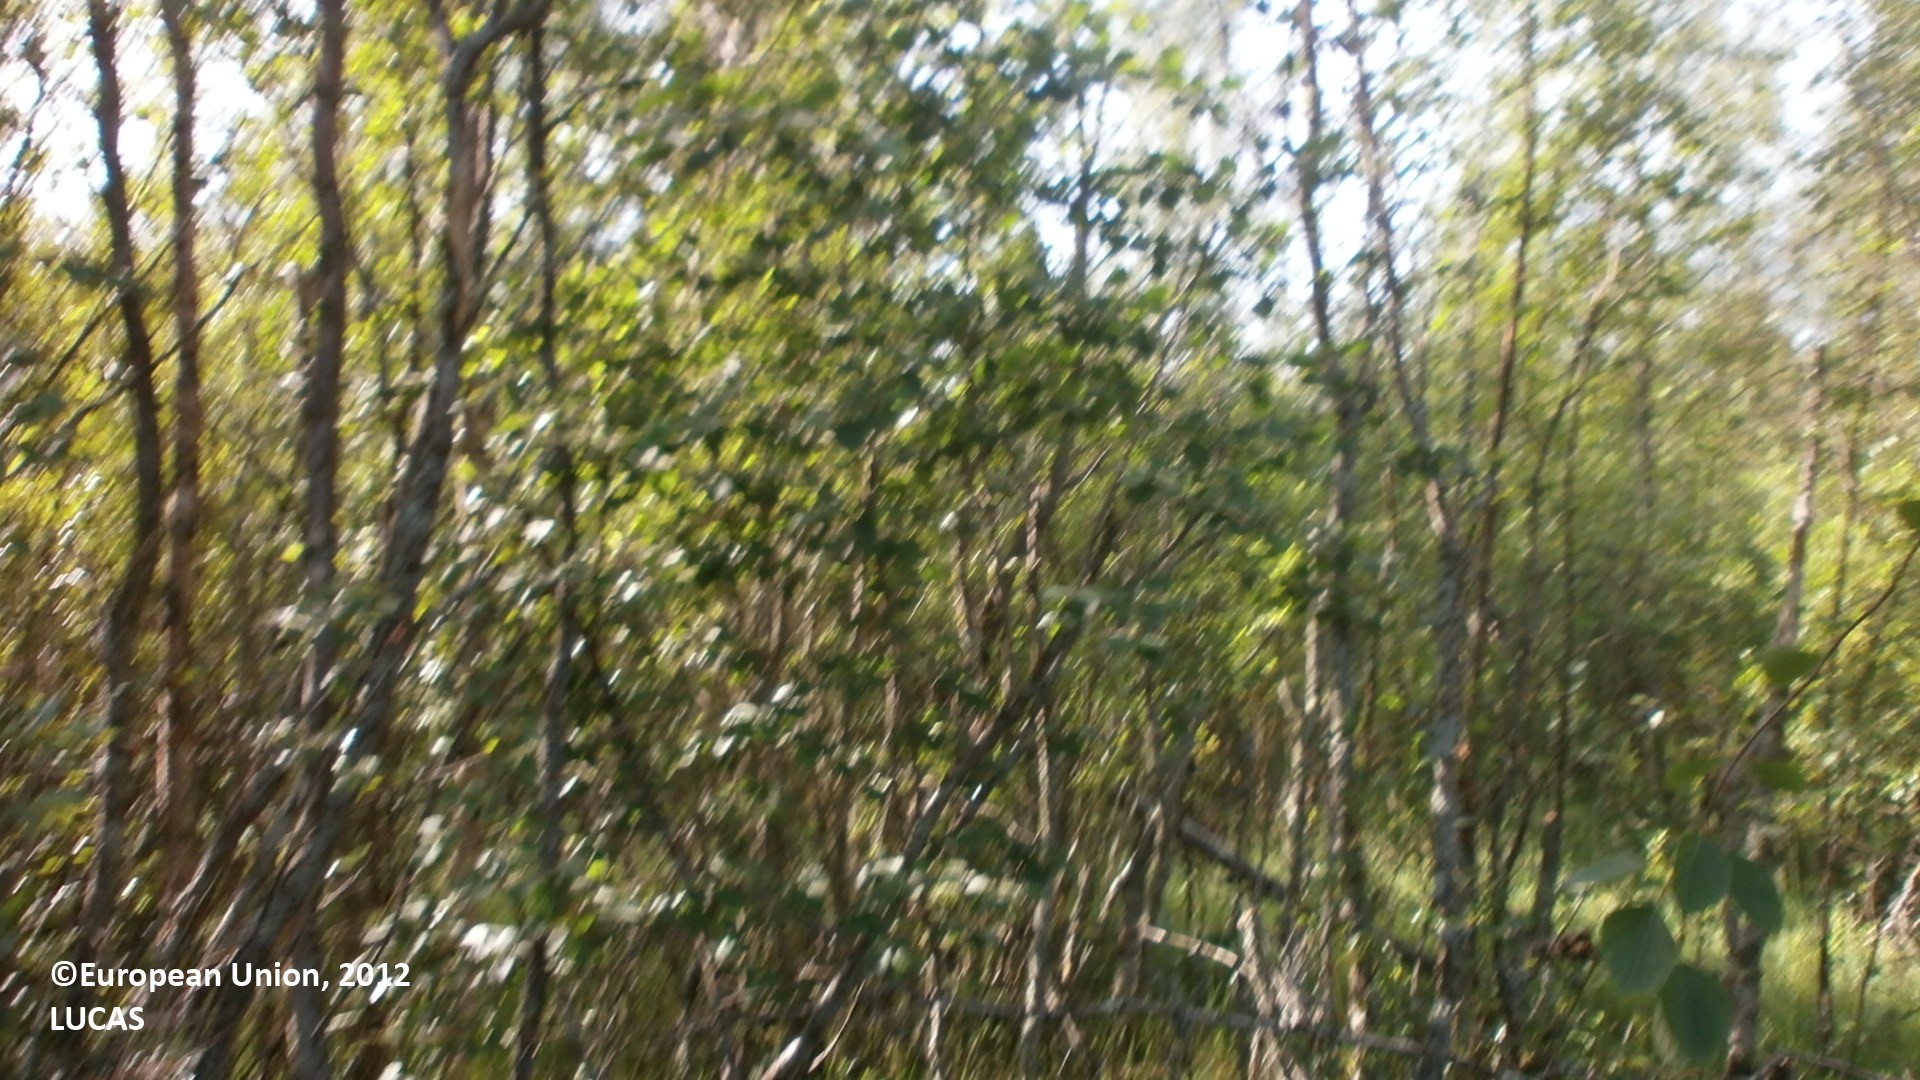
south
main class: Woodland
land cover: Broadleaved woodland
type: boreal forest
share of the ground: > 75 %
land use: Forestry
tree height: > 5 m
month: July
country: FI
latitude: 64.4256
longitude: 24.1189
